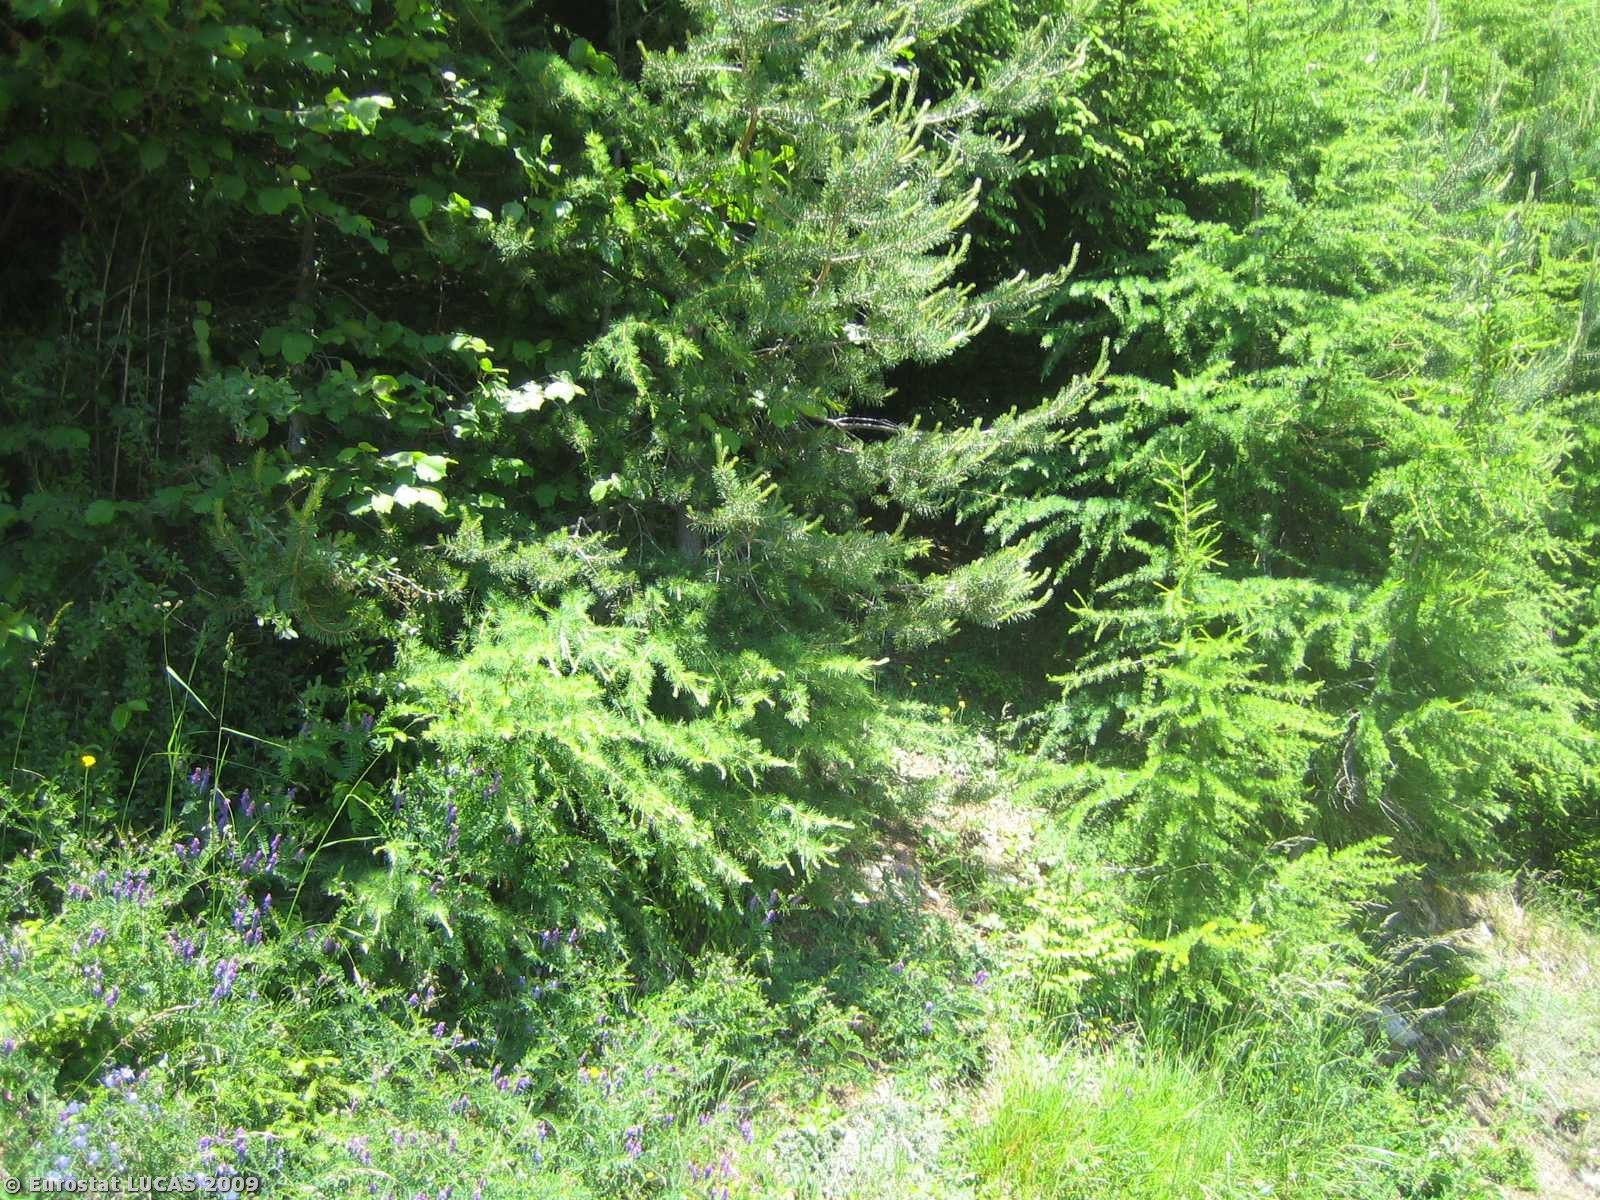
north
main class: Artificial land
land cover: Non built-up linear features
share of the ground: > 75 %
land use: Road transport
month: June
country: IT
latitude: 46.8242
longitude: 11.6892
